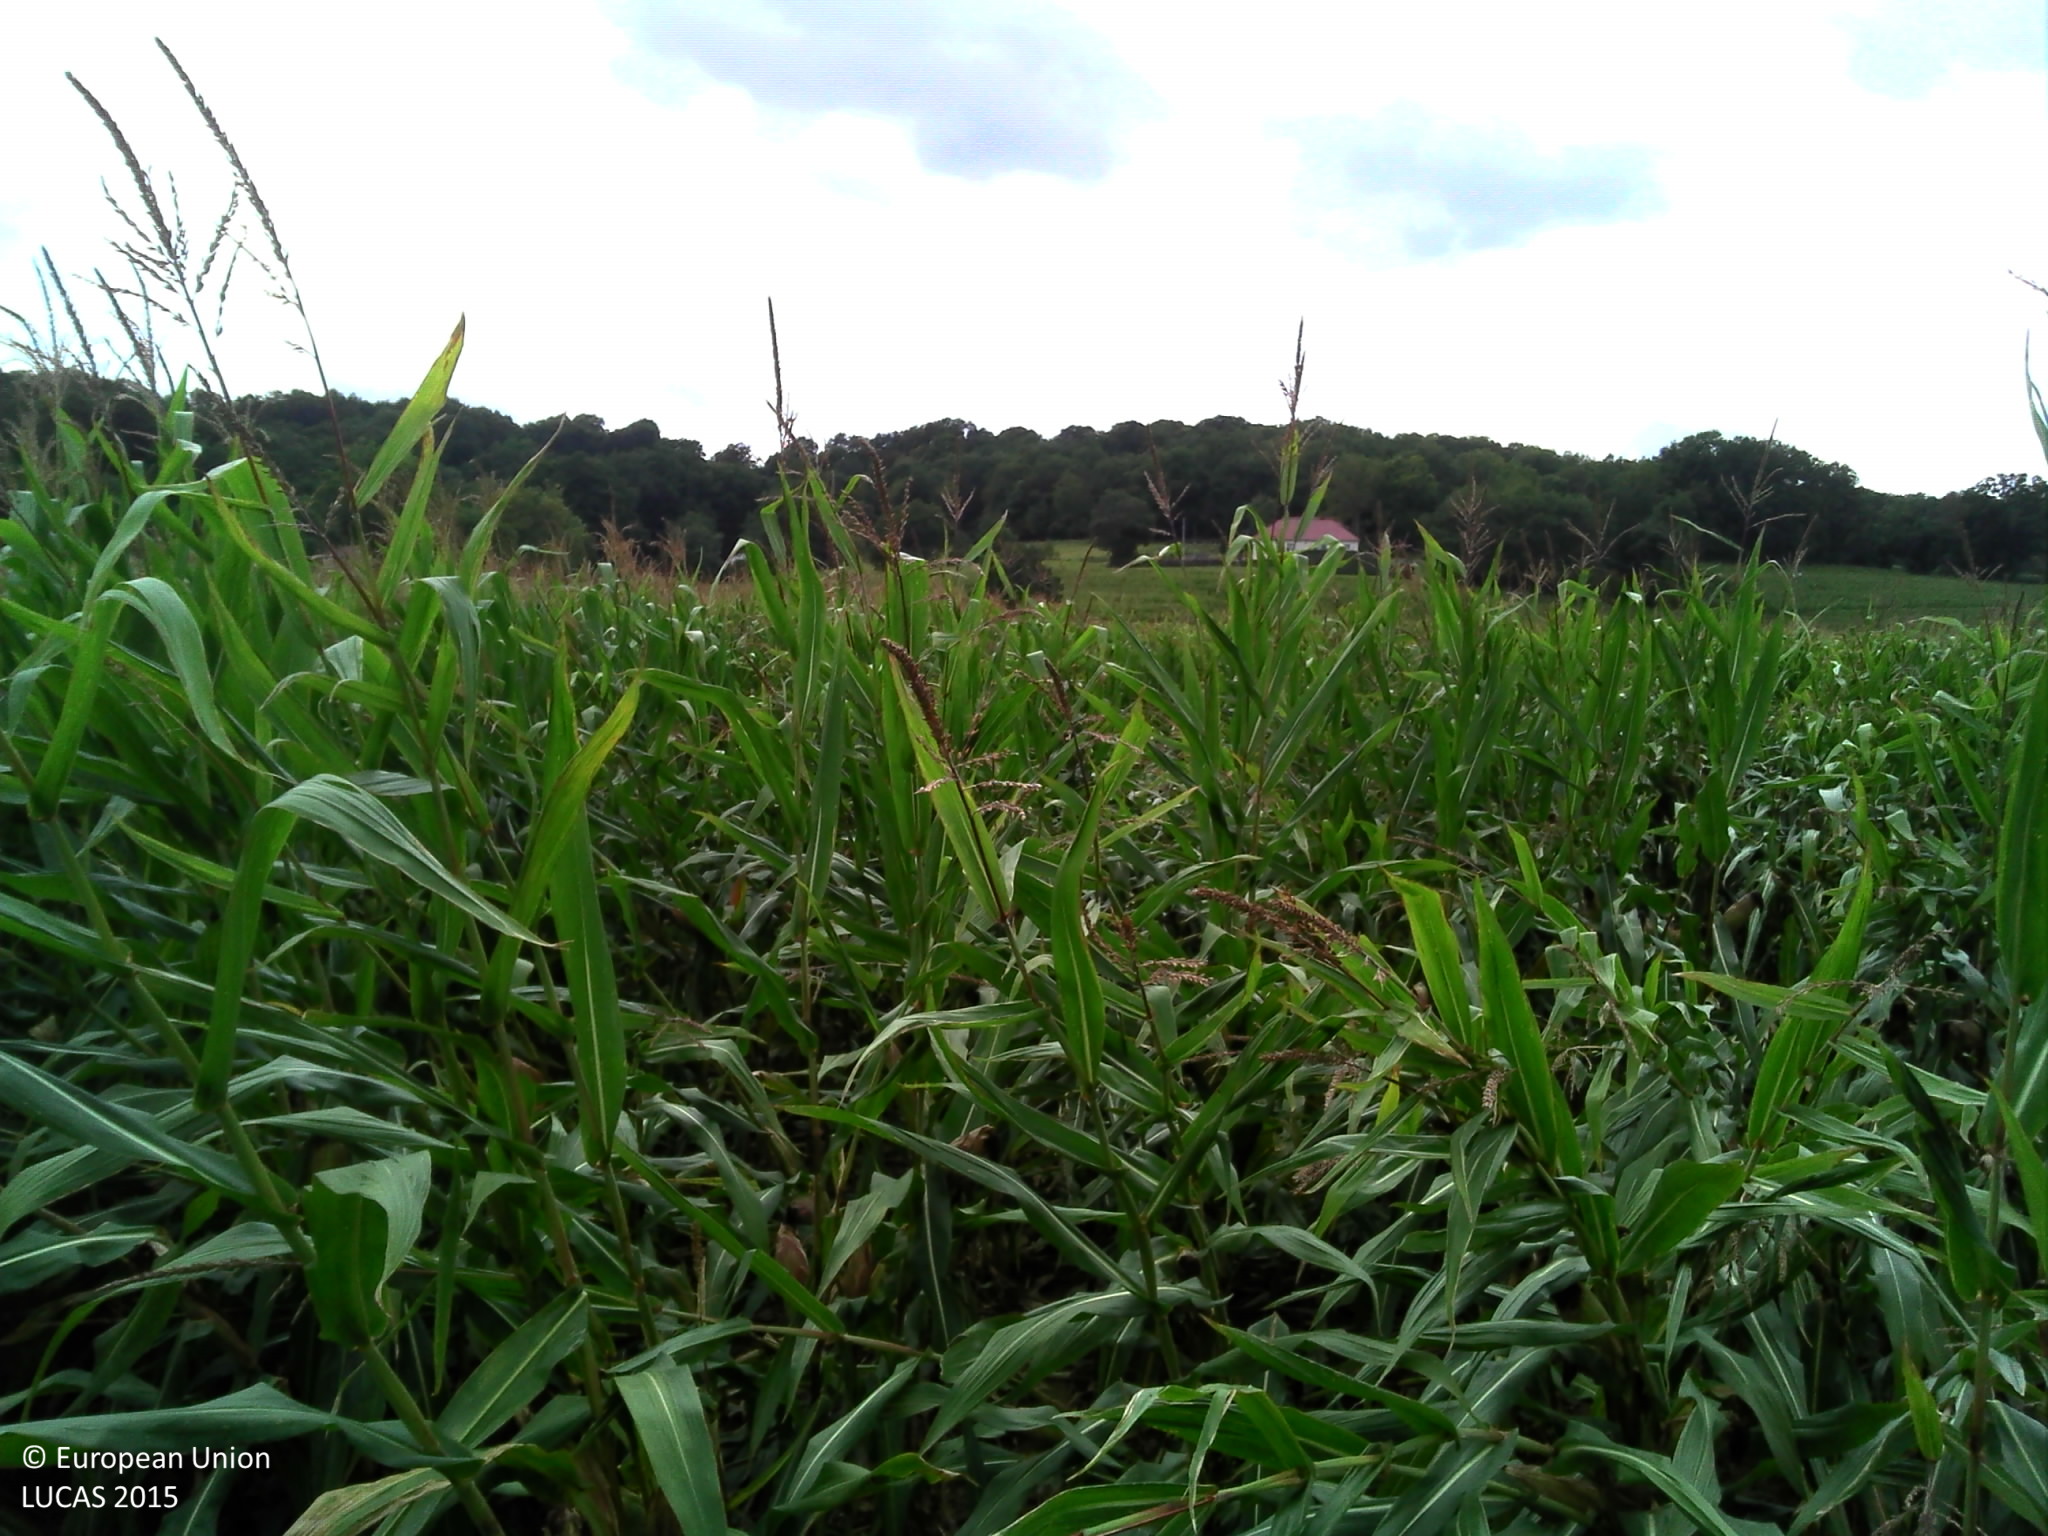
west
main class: Cropland
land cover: Maize
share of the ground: > 75 %
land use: Agriculture (excluding fallow land and kitchen gardens)
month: September
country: FR
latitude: 43.4850
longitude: -0.1825
